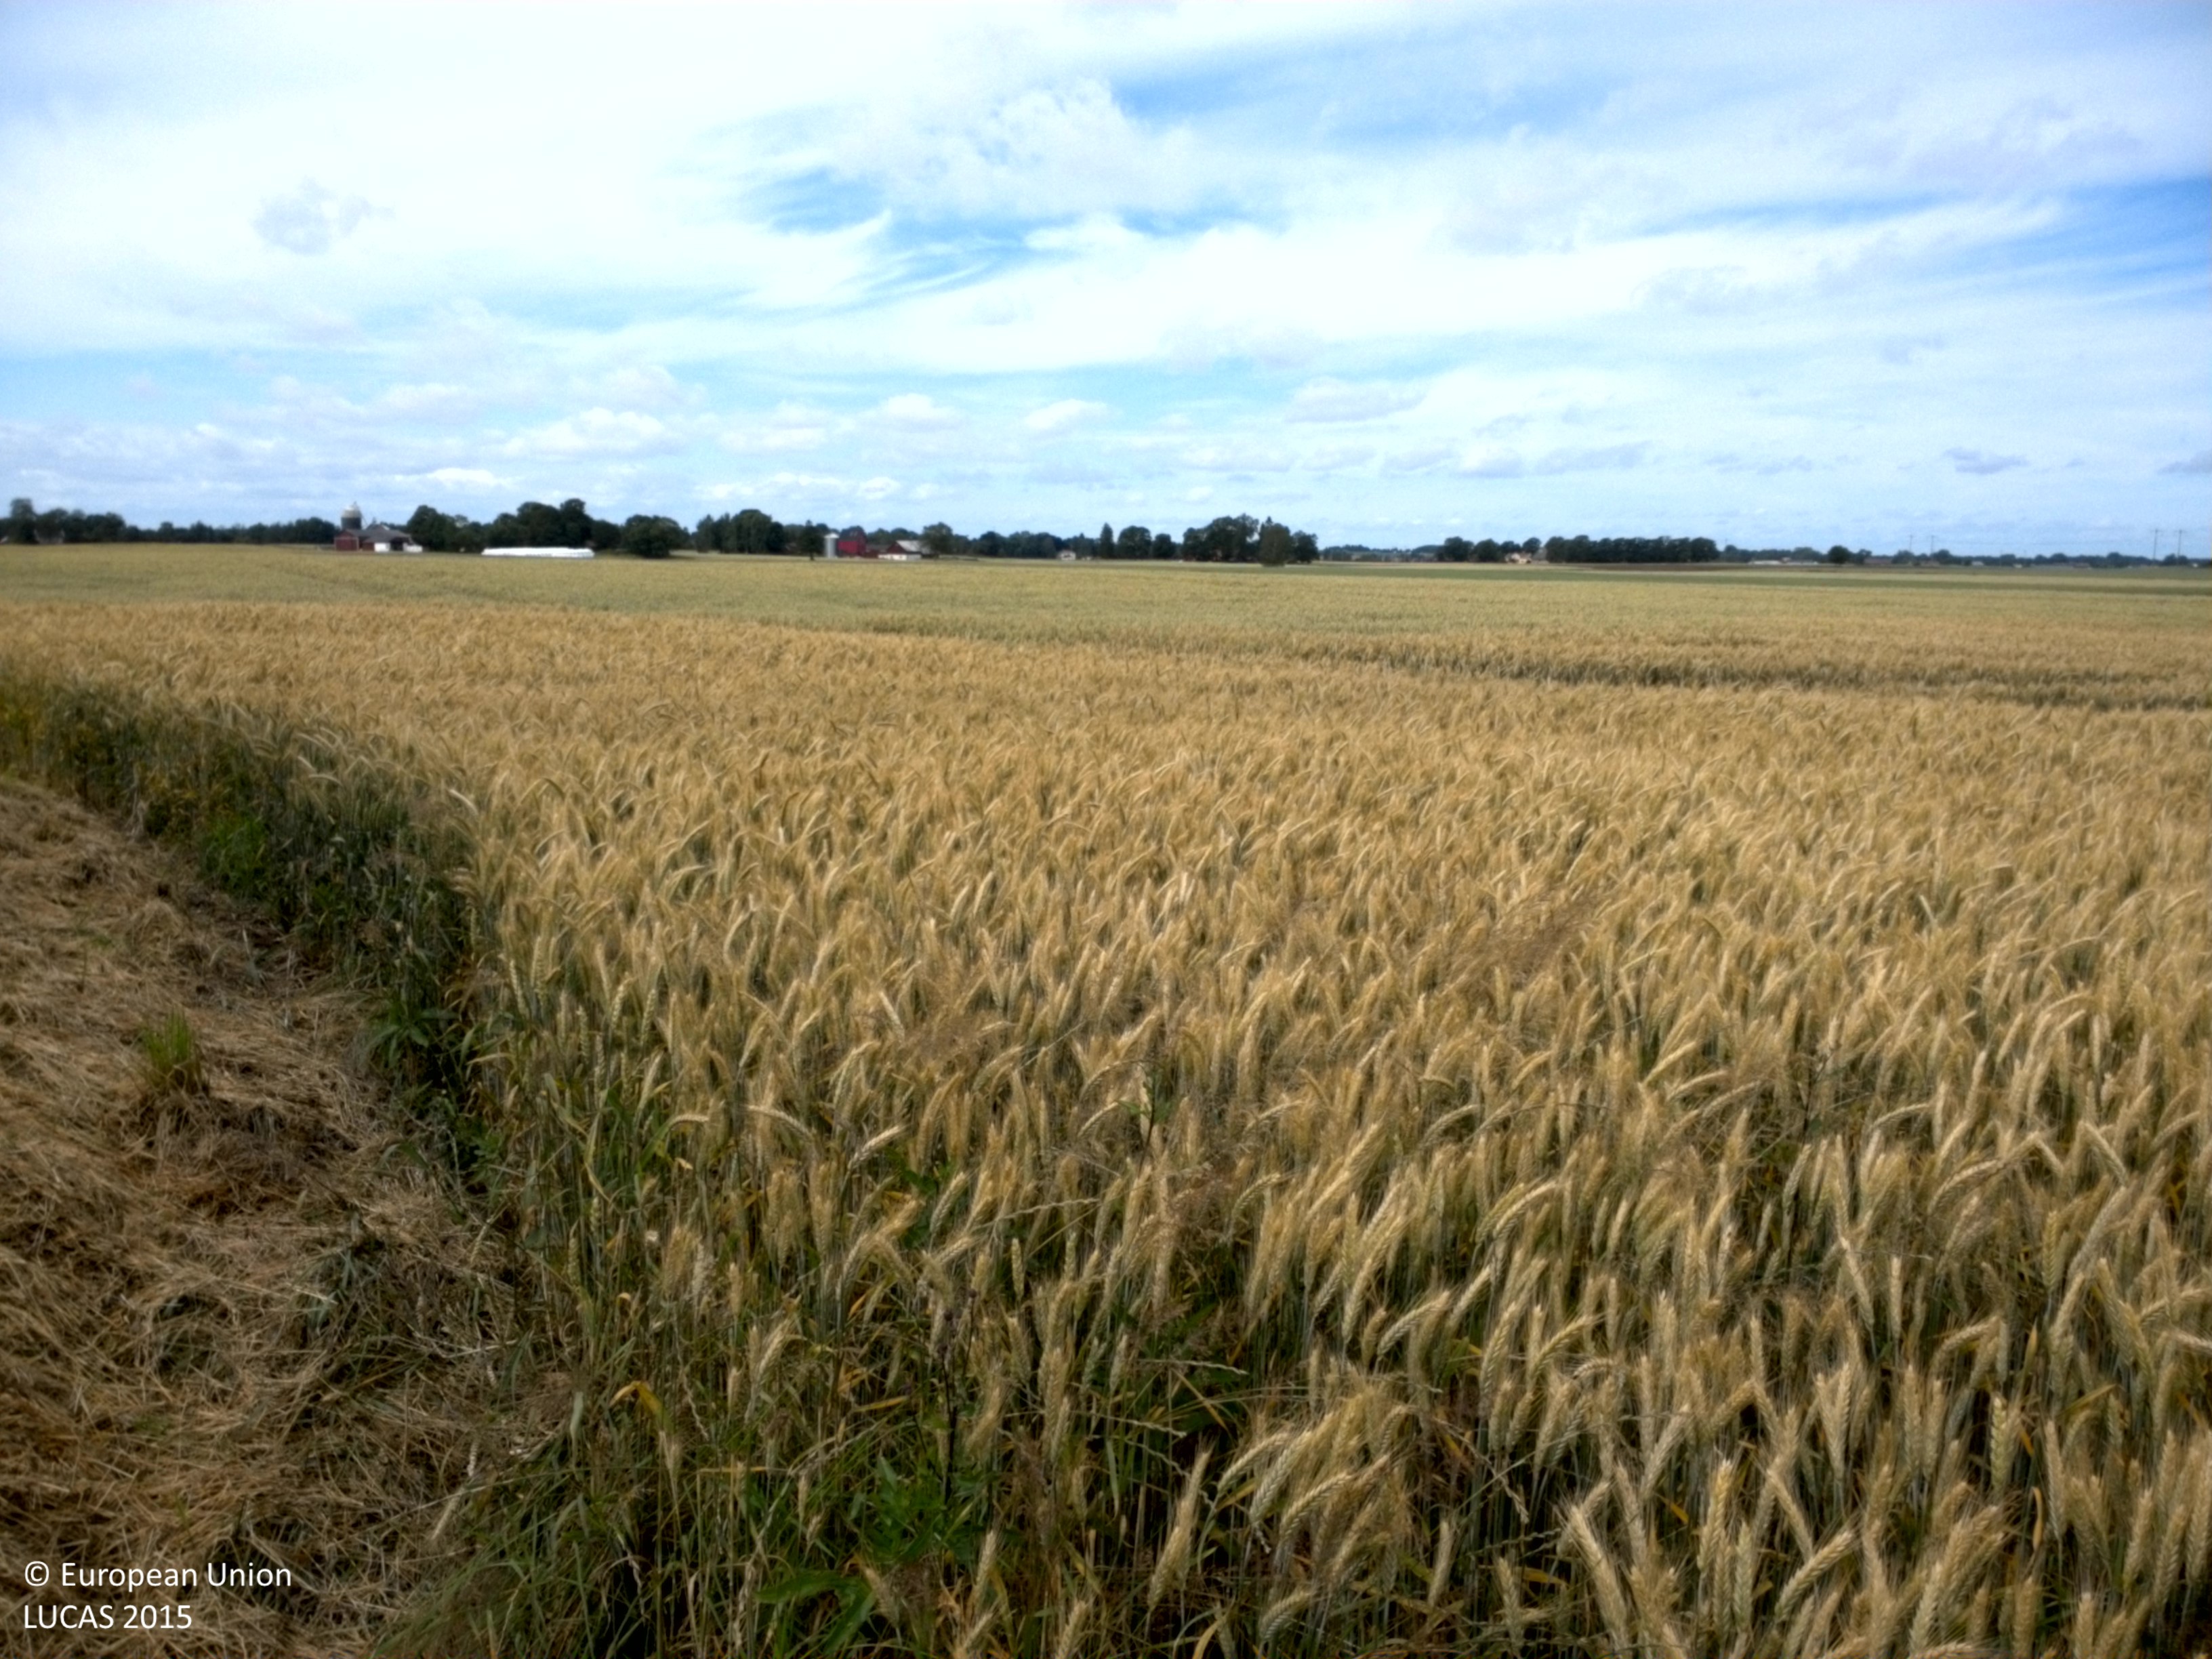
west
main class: Cropland
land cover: Oats
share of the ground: > 75 %
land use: Agriculture (excluding fallow land and kitchen gardens)
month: July
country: SE
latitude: 58.5013
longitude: 13.3744
